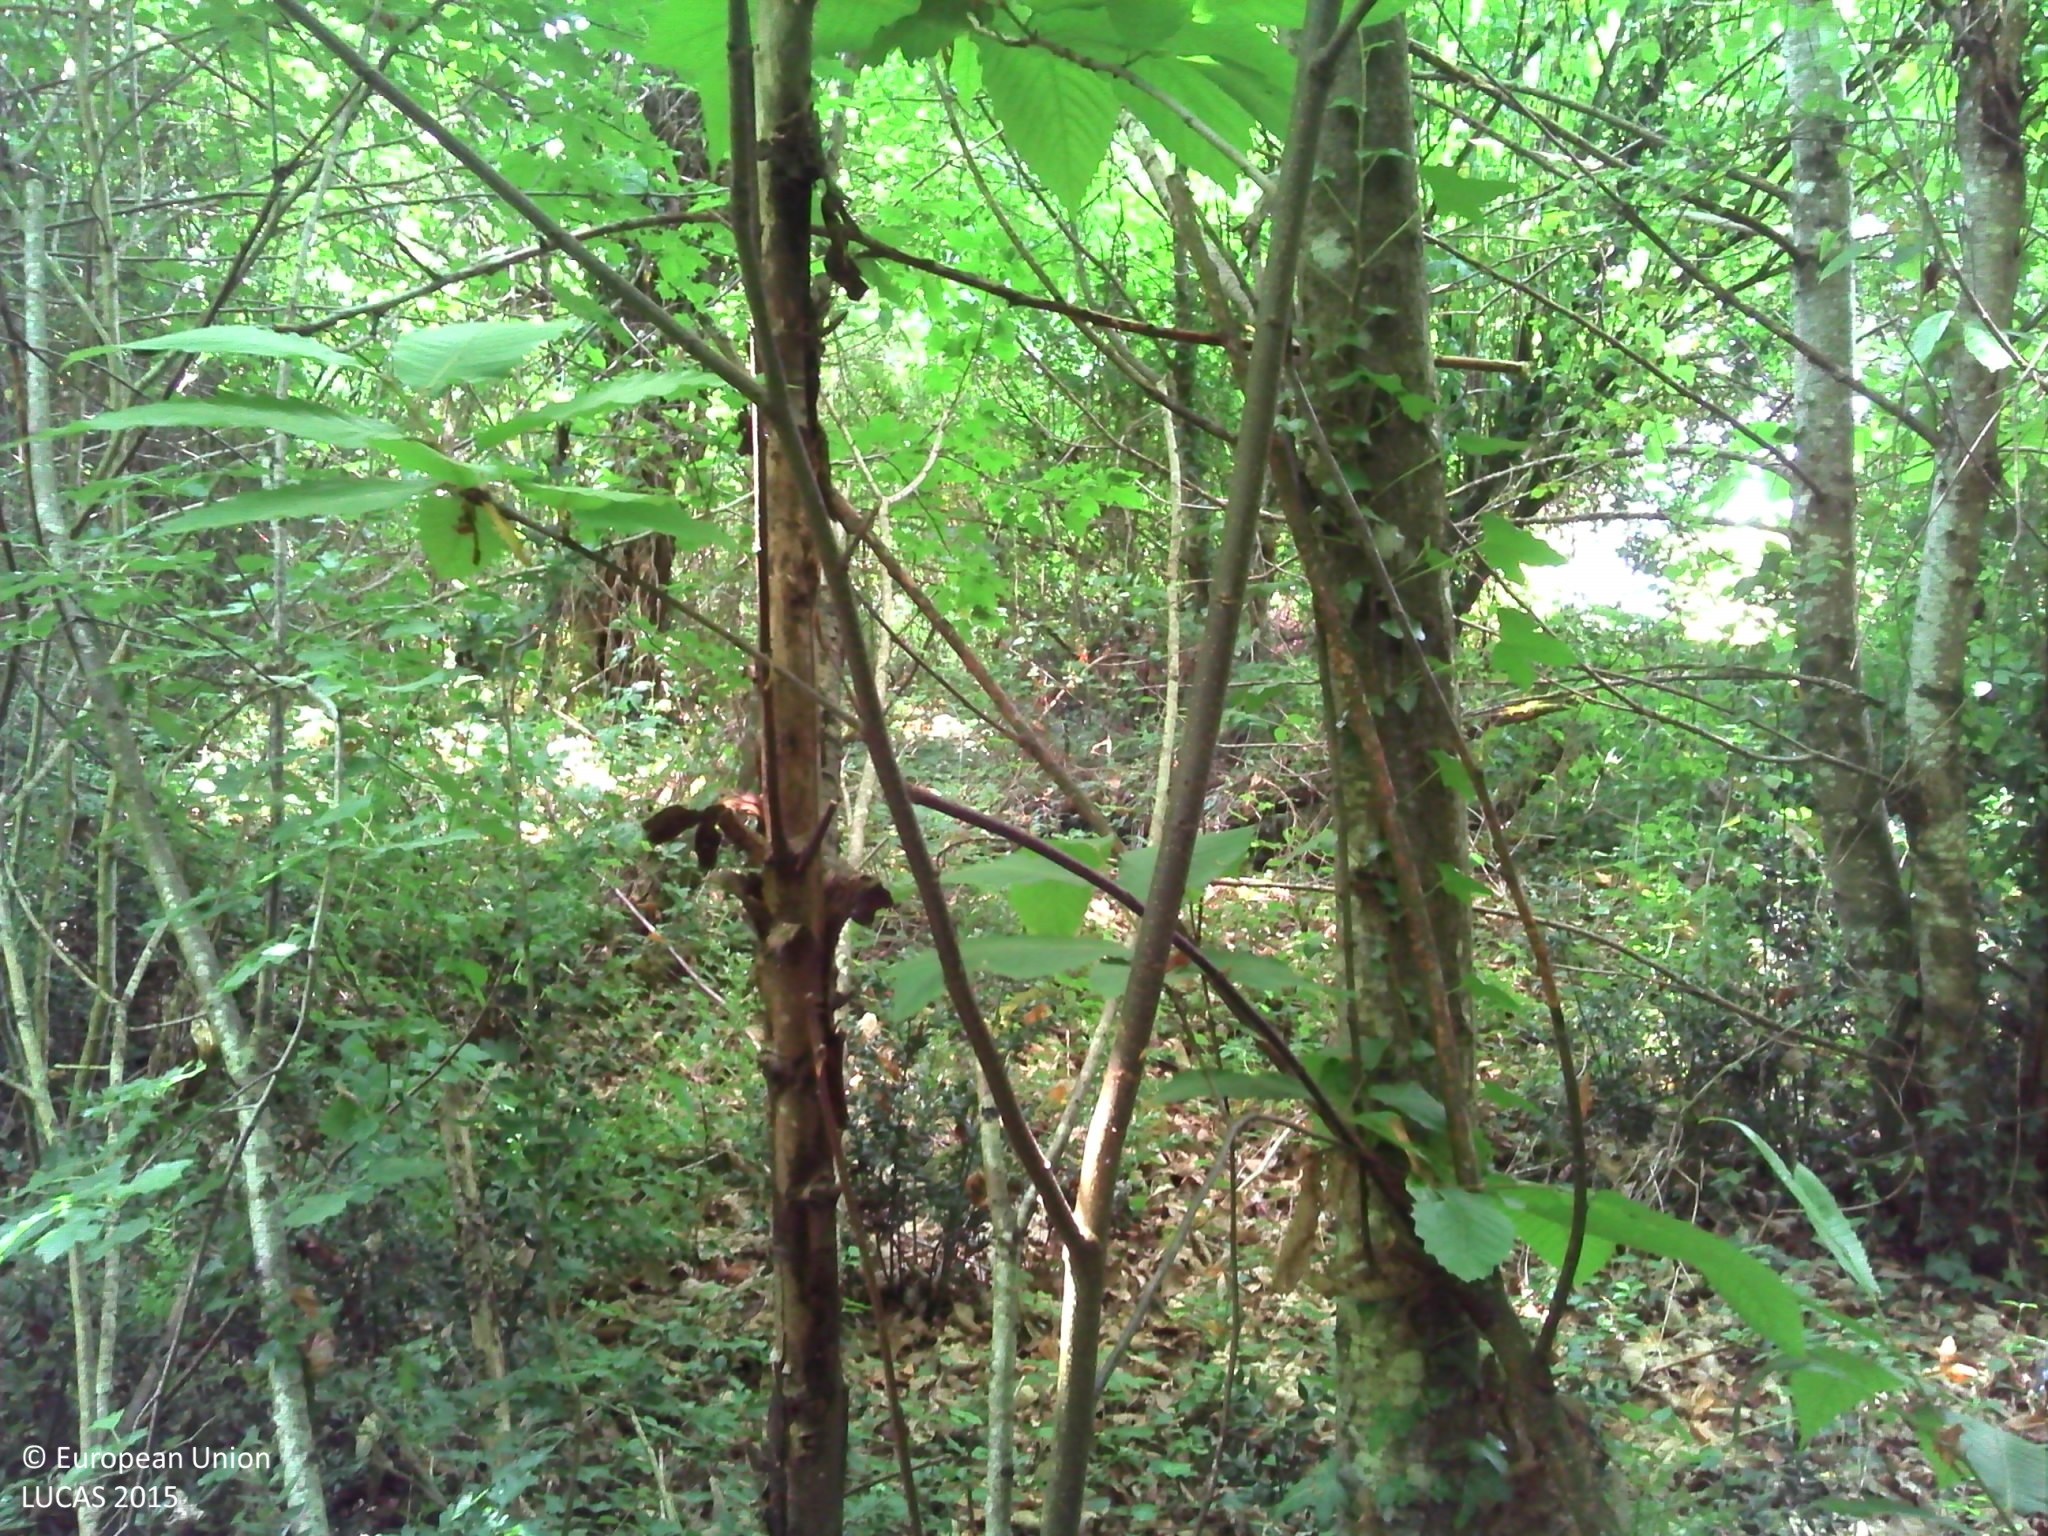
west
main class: Woodland
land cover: Broadleaved woodland
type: thermophilous deciduous forest
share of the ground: > 75 %
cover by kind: broadleaved forest trees 100 %
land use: Forestry
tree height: > 5 m
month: June
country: FR
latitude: 45.8762
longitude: 0.3340
